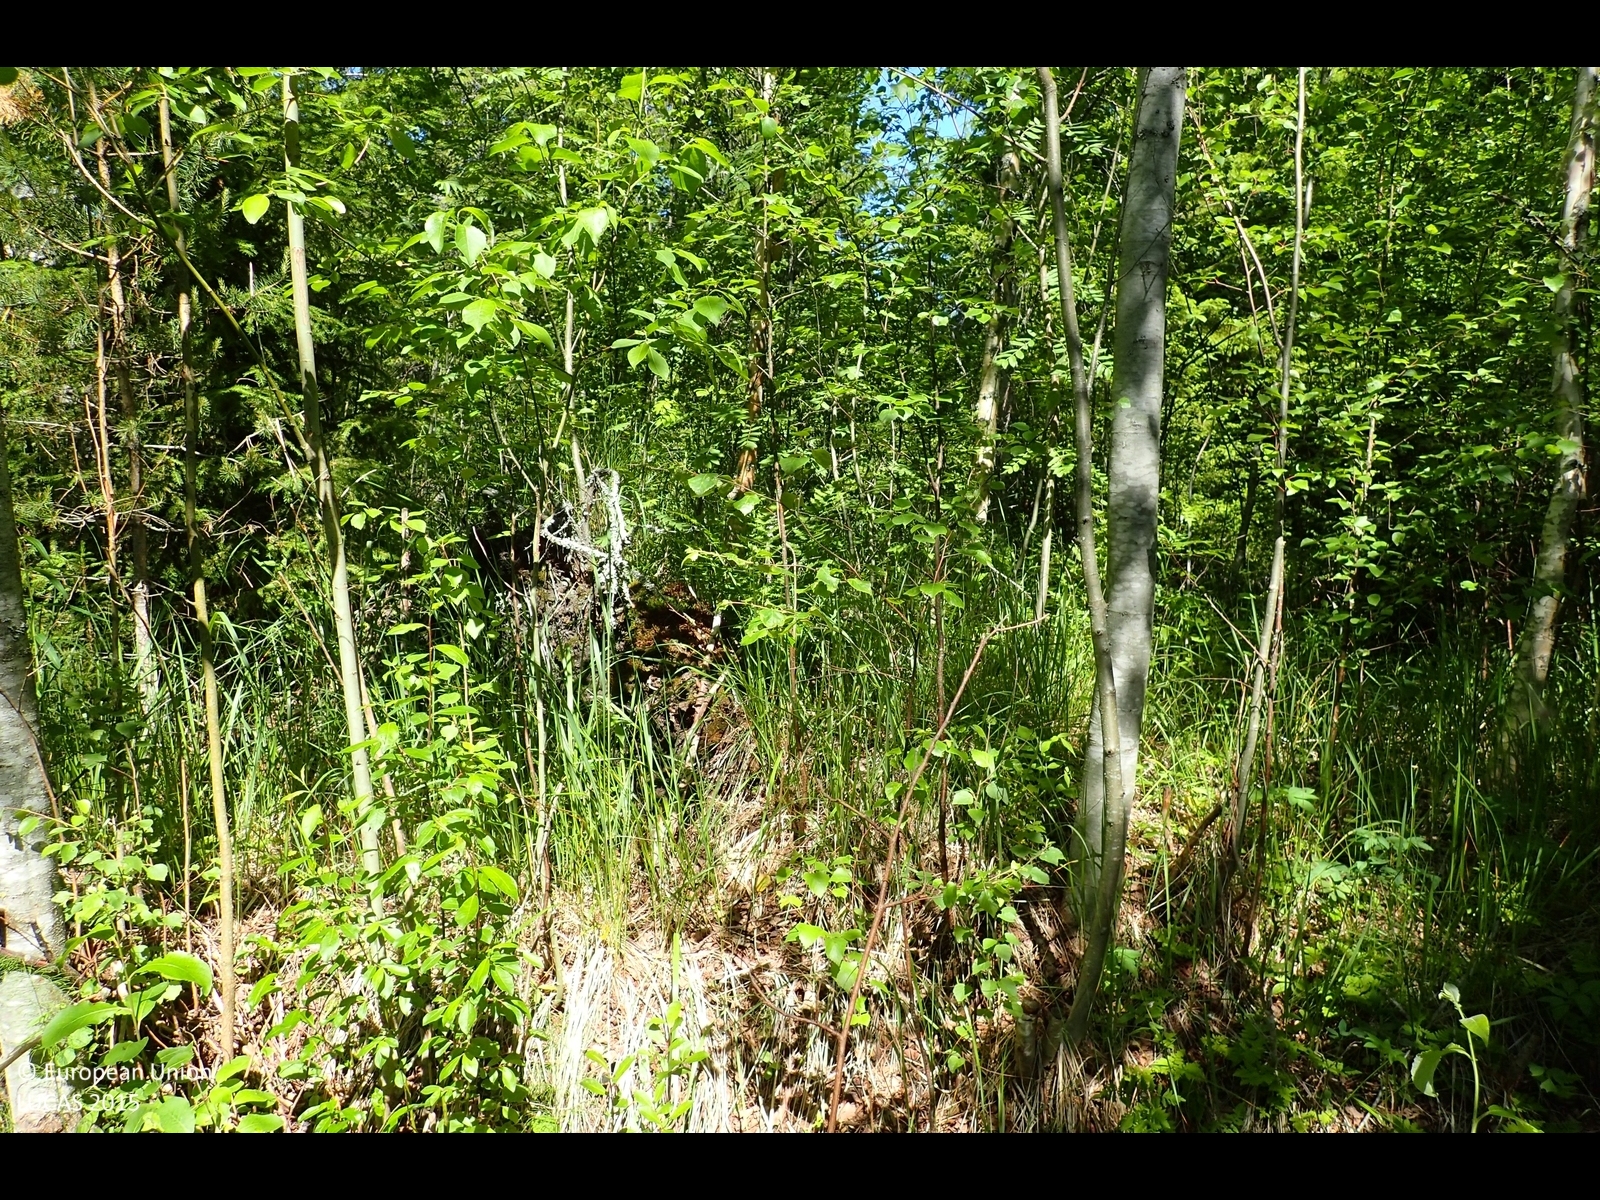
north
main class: Woodland
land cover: Broadleaved woodland
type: boreal forest
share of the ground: > 75 %
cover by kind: broadleaved forest trees 60 %, herbaceous plants 25 %, coniferous forest trees 15 %
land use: Forestry
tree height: > 5 m
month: July
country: FI
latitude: 62.4888
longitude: 21.6298
